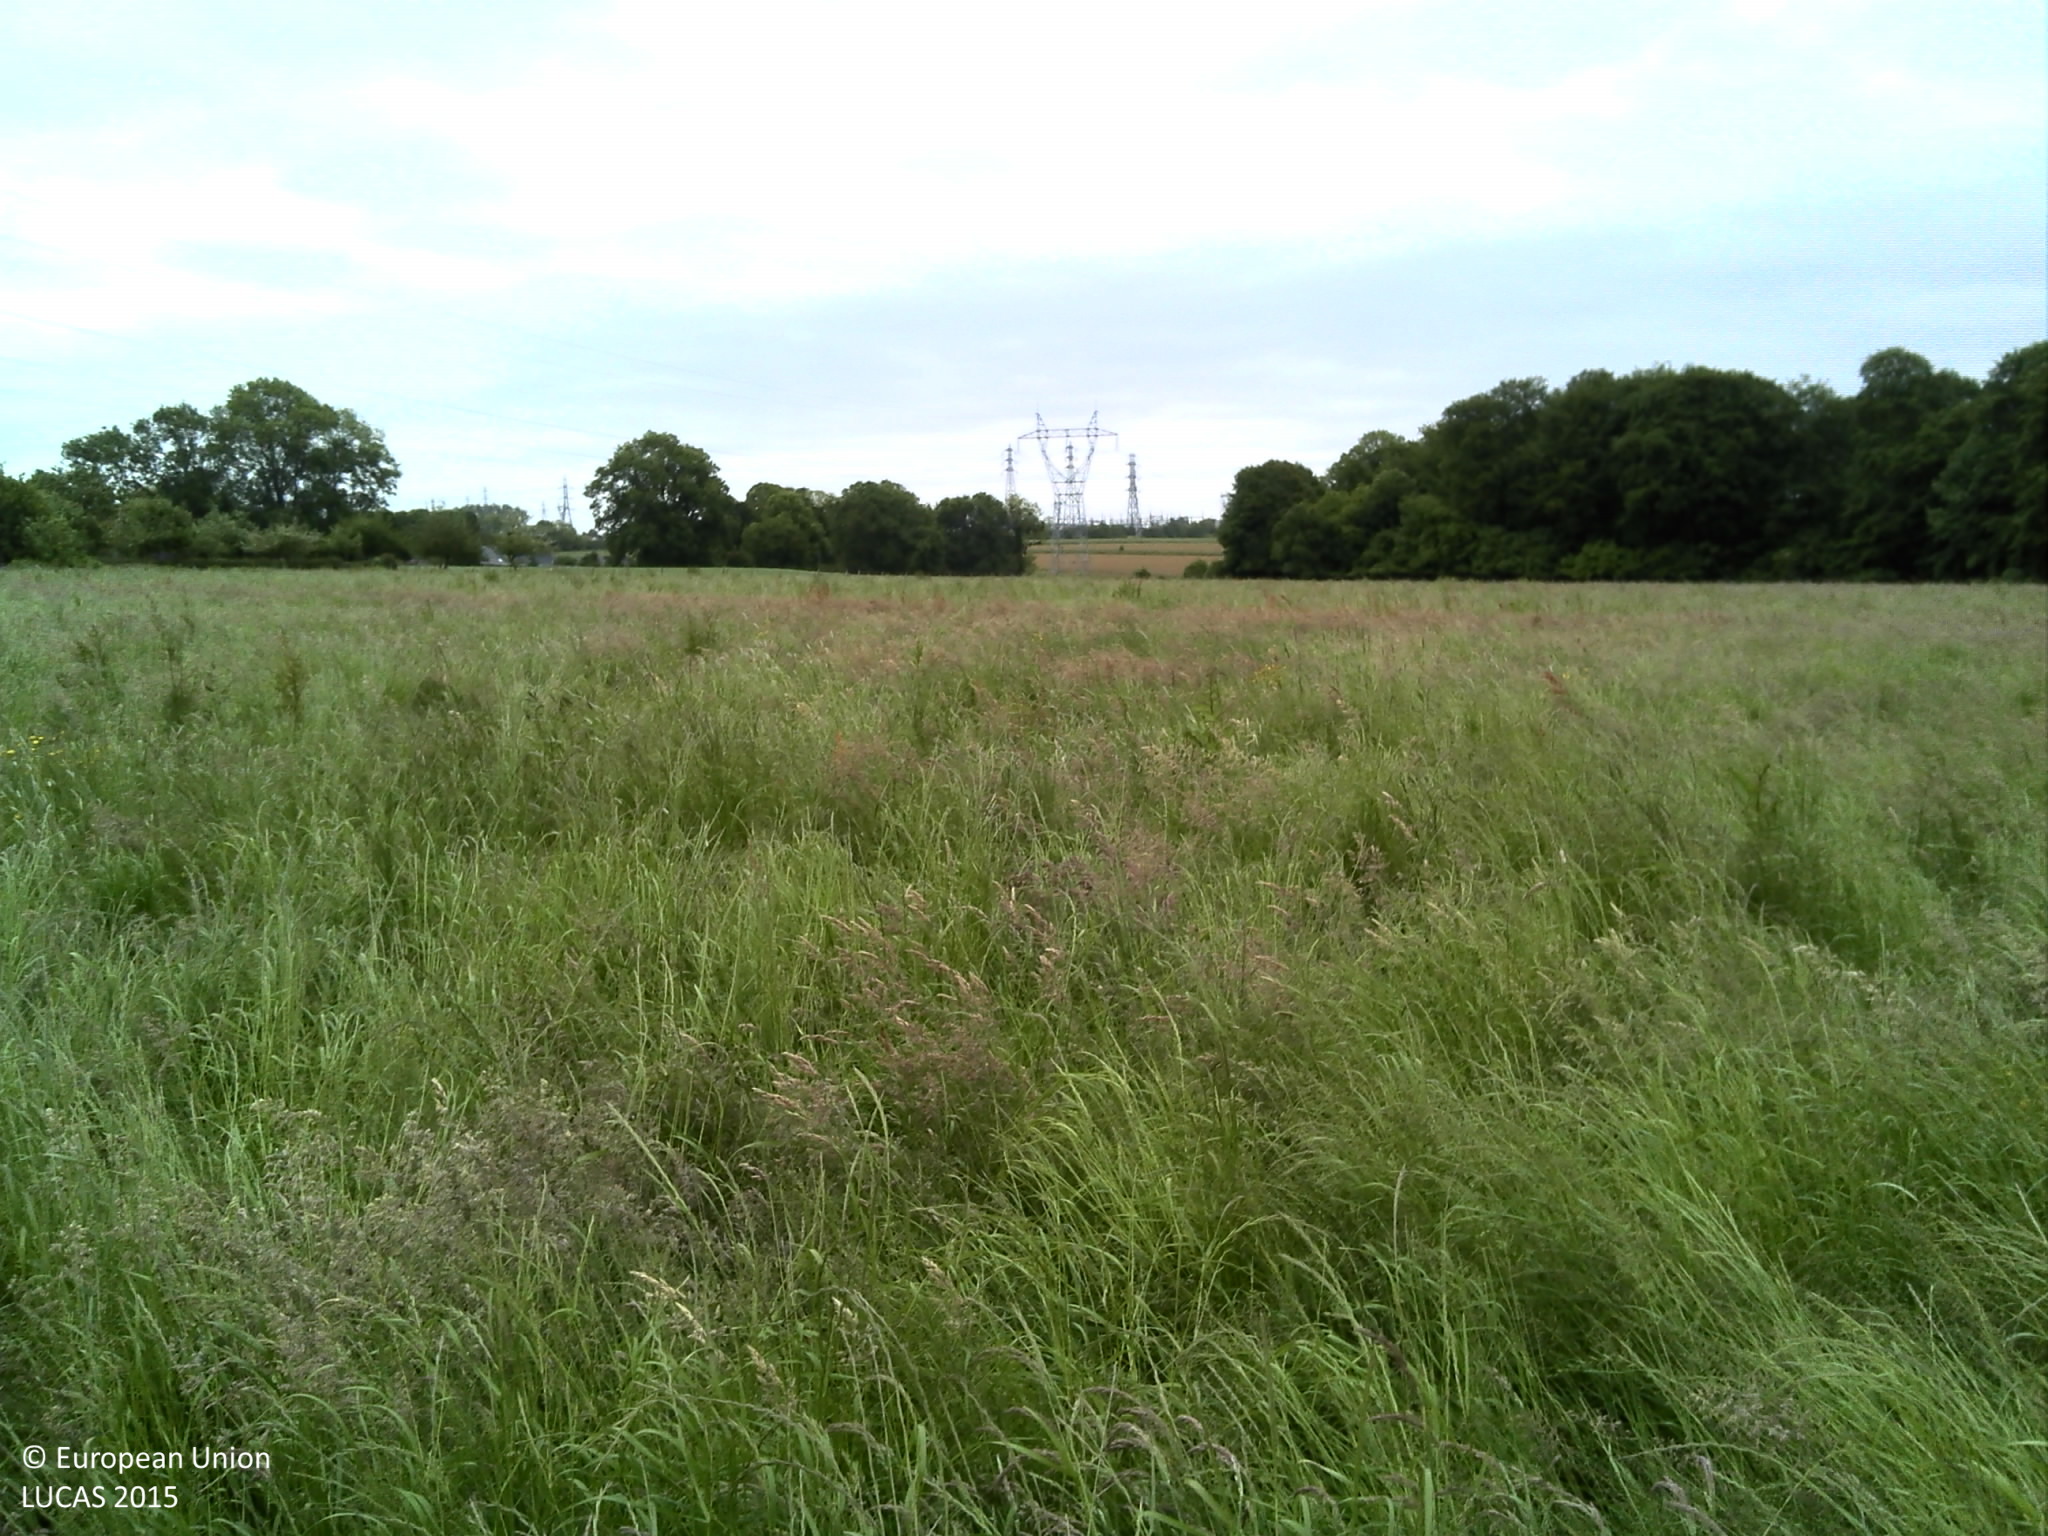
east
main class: Grassland
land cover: Grassland without tree/shrub cover
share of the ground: > 75 %
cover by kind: herbaceous plants 100 %
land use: Agriculture (excluding fallow land and kitchen gardens)
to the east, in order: Grassland without tree/shrub cover; Fences; Grassland without tree/shrub cover; Fences; Grassland without tree/shrub cover; Fences; Grassland without tree/shrub cover
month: June
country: FR
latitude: 49.4832
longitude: 0.9917
